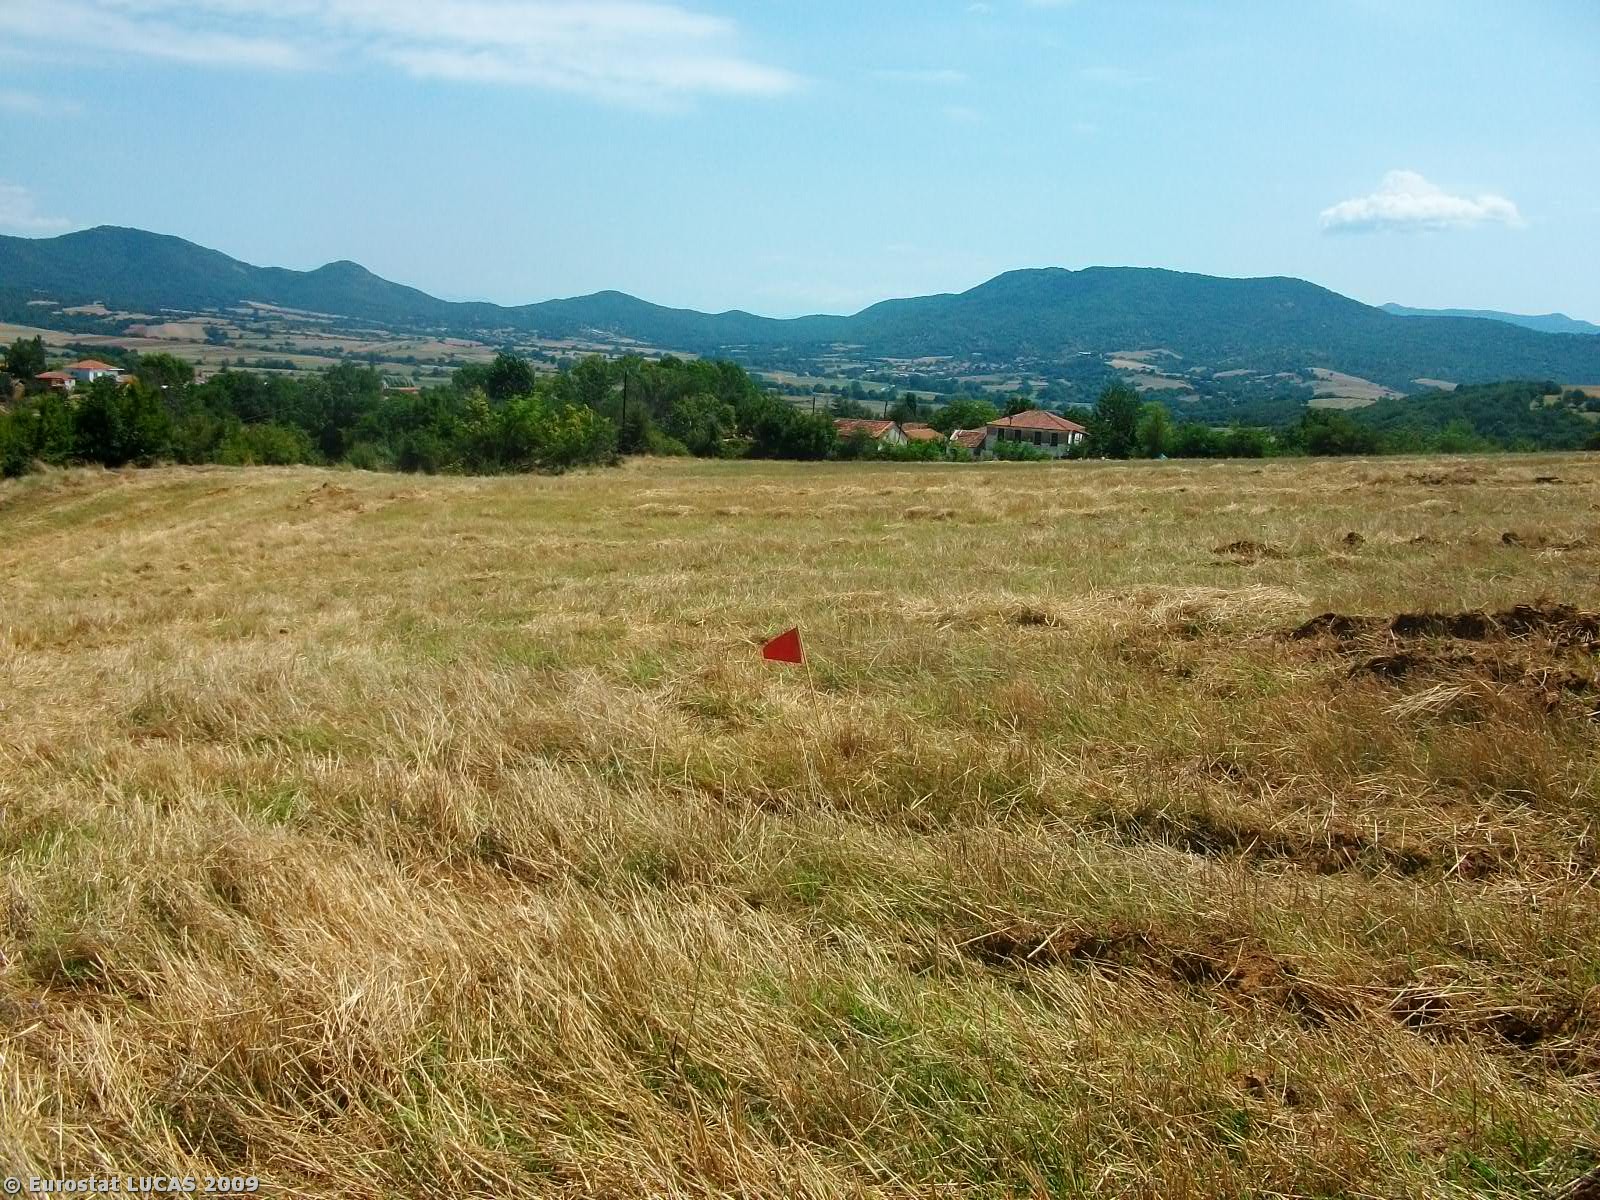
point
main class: Cropland
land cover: Barley
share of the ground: < 10 %
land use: Agriculture (excluding fallow land and kitchen gardens)
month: July
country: GR
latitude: 41.1409
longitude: 22.9635
